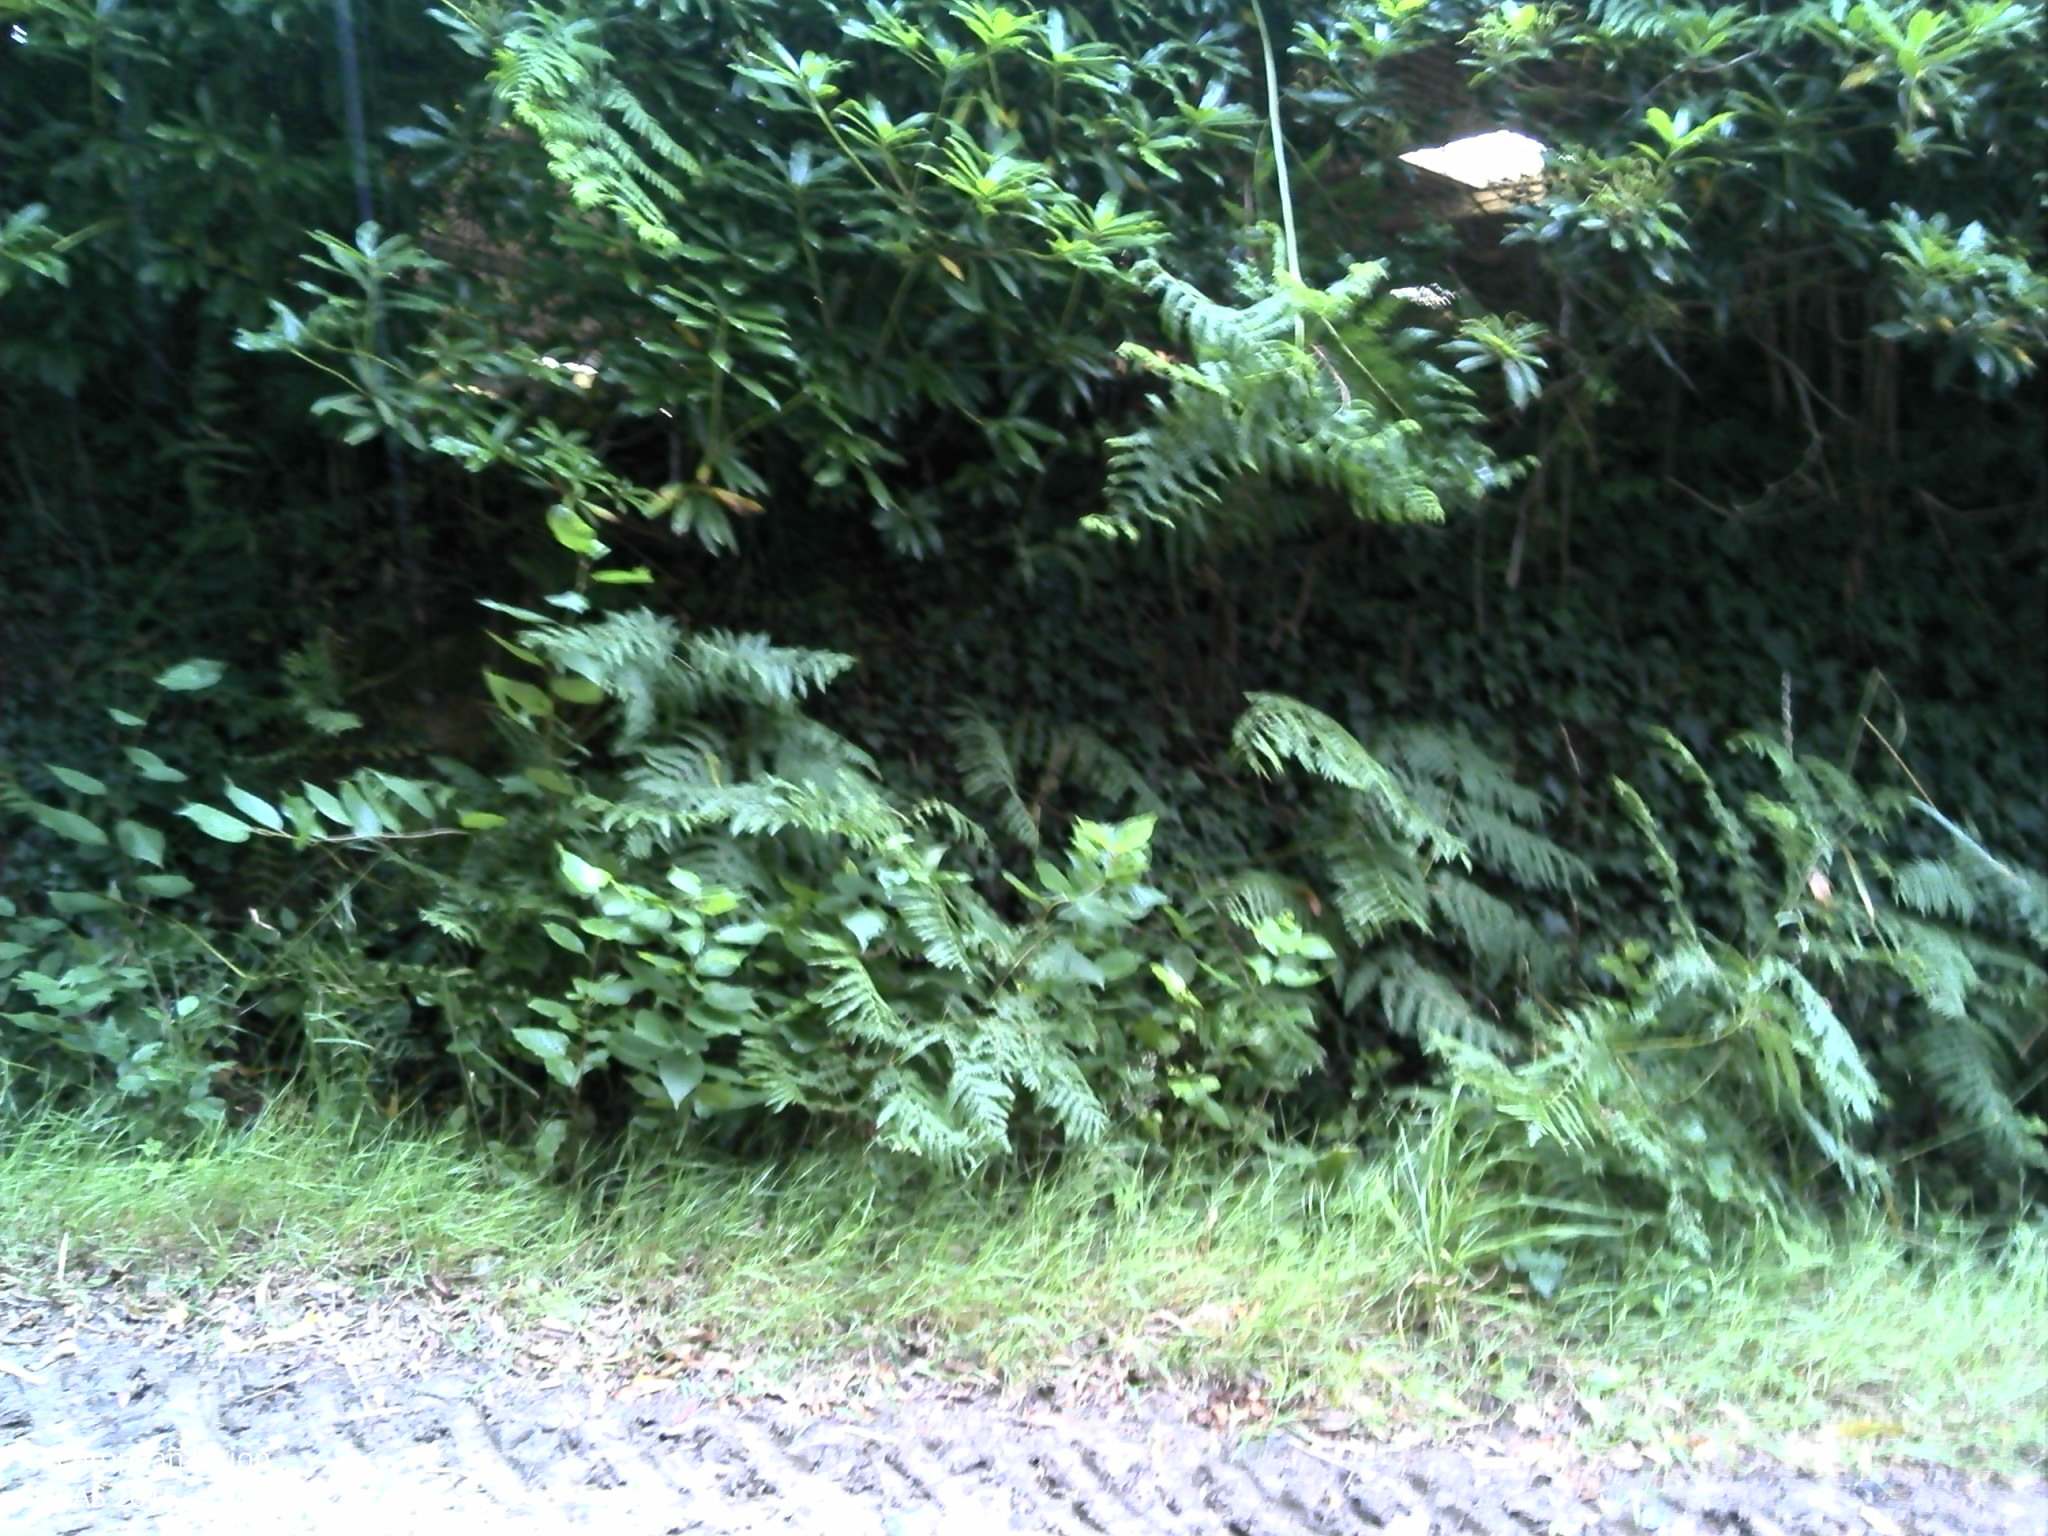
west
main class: Woodland
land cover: Broadleaved woodland
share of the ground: > 75 %
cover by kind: broadleaved forest trees 100 %
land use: Semi-natural and natural areas not in use
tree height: > 5 m
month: July
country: FR
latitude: 48.3903
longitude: -4.2322
